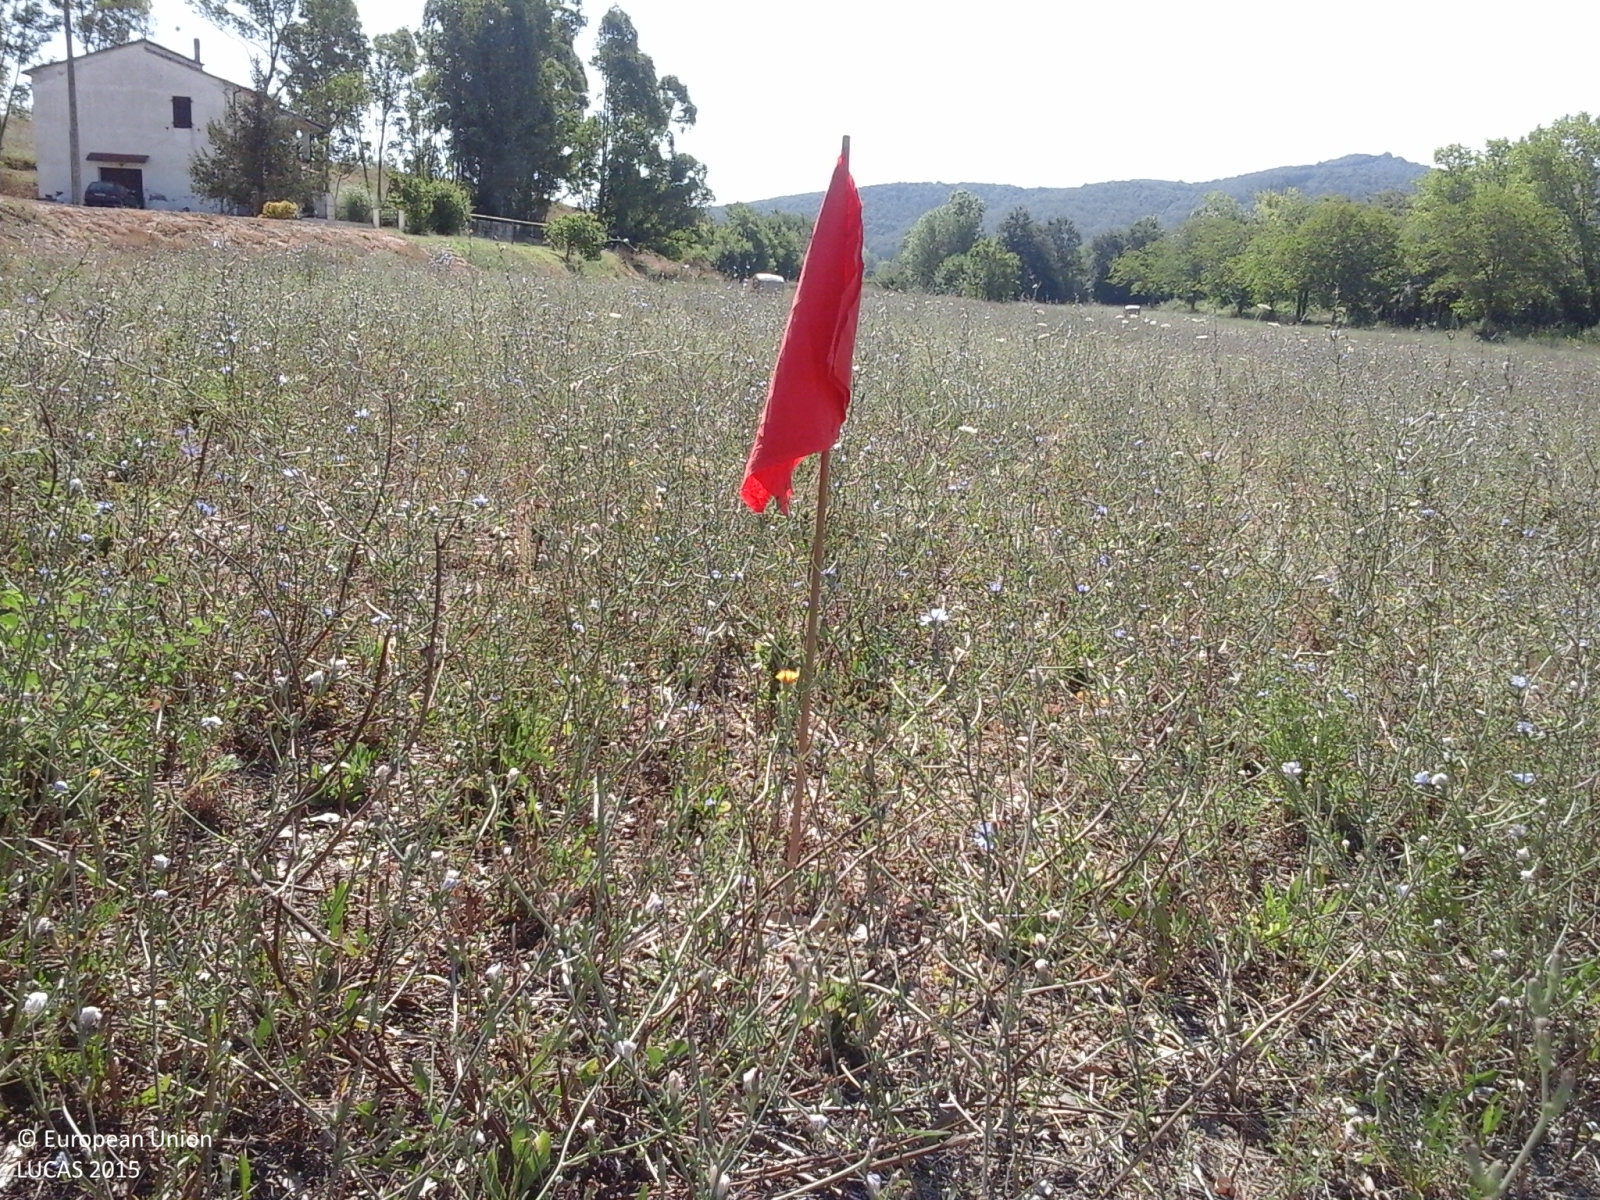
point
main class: Grassland
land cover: Spontaneously vegetated surfaces
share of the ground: > 75 %
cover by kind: herbaceous plants 100 %
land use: Agriculture (excluding fallow land and kitchen gardens)
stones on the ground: < 10 %
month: July
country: IT
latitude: 42.9747
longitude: 10.9412
